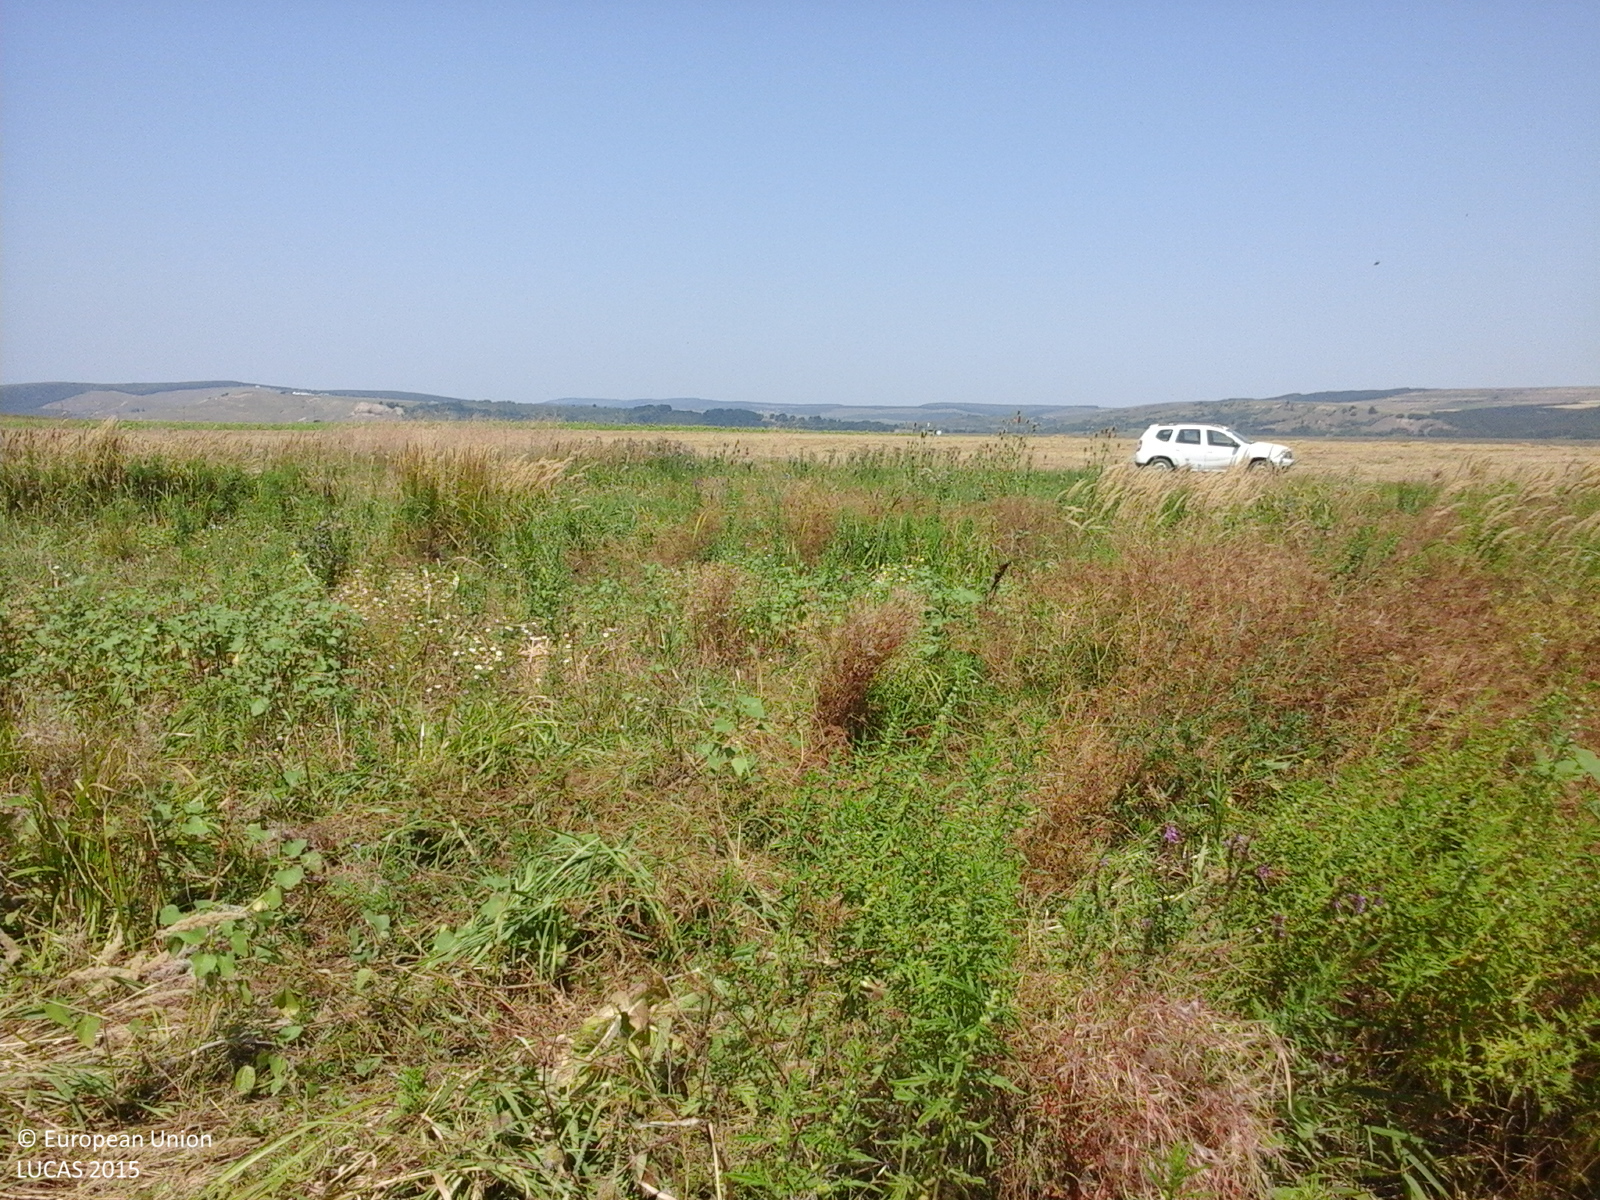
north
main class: Grassland
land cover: Spontaneously vegetated surfaces
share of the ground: > 75 %
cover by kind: herbaceous plants 100 %
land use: Fallow land
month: August
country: RO
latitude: 46.2269
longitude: 27.1210
